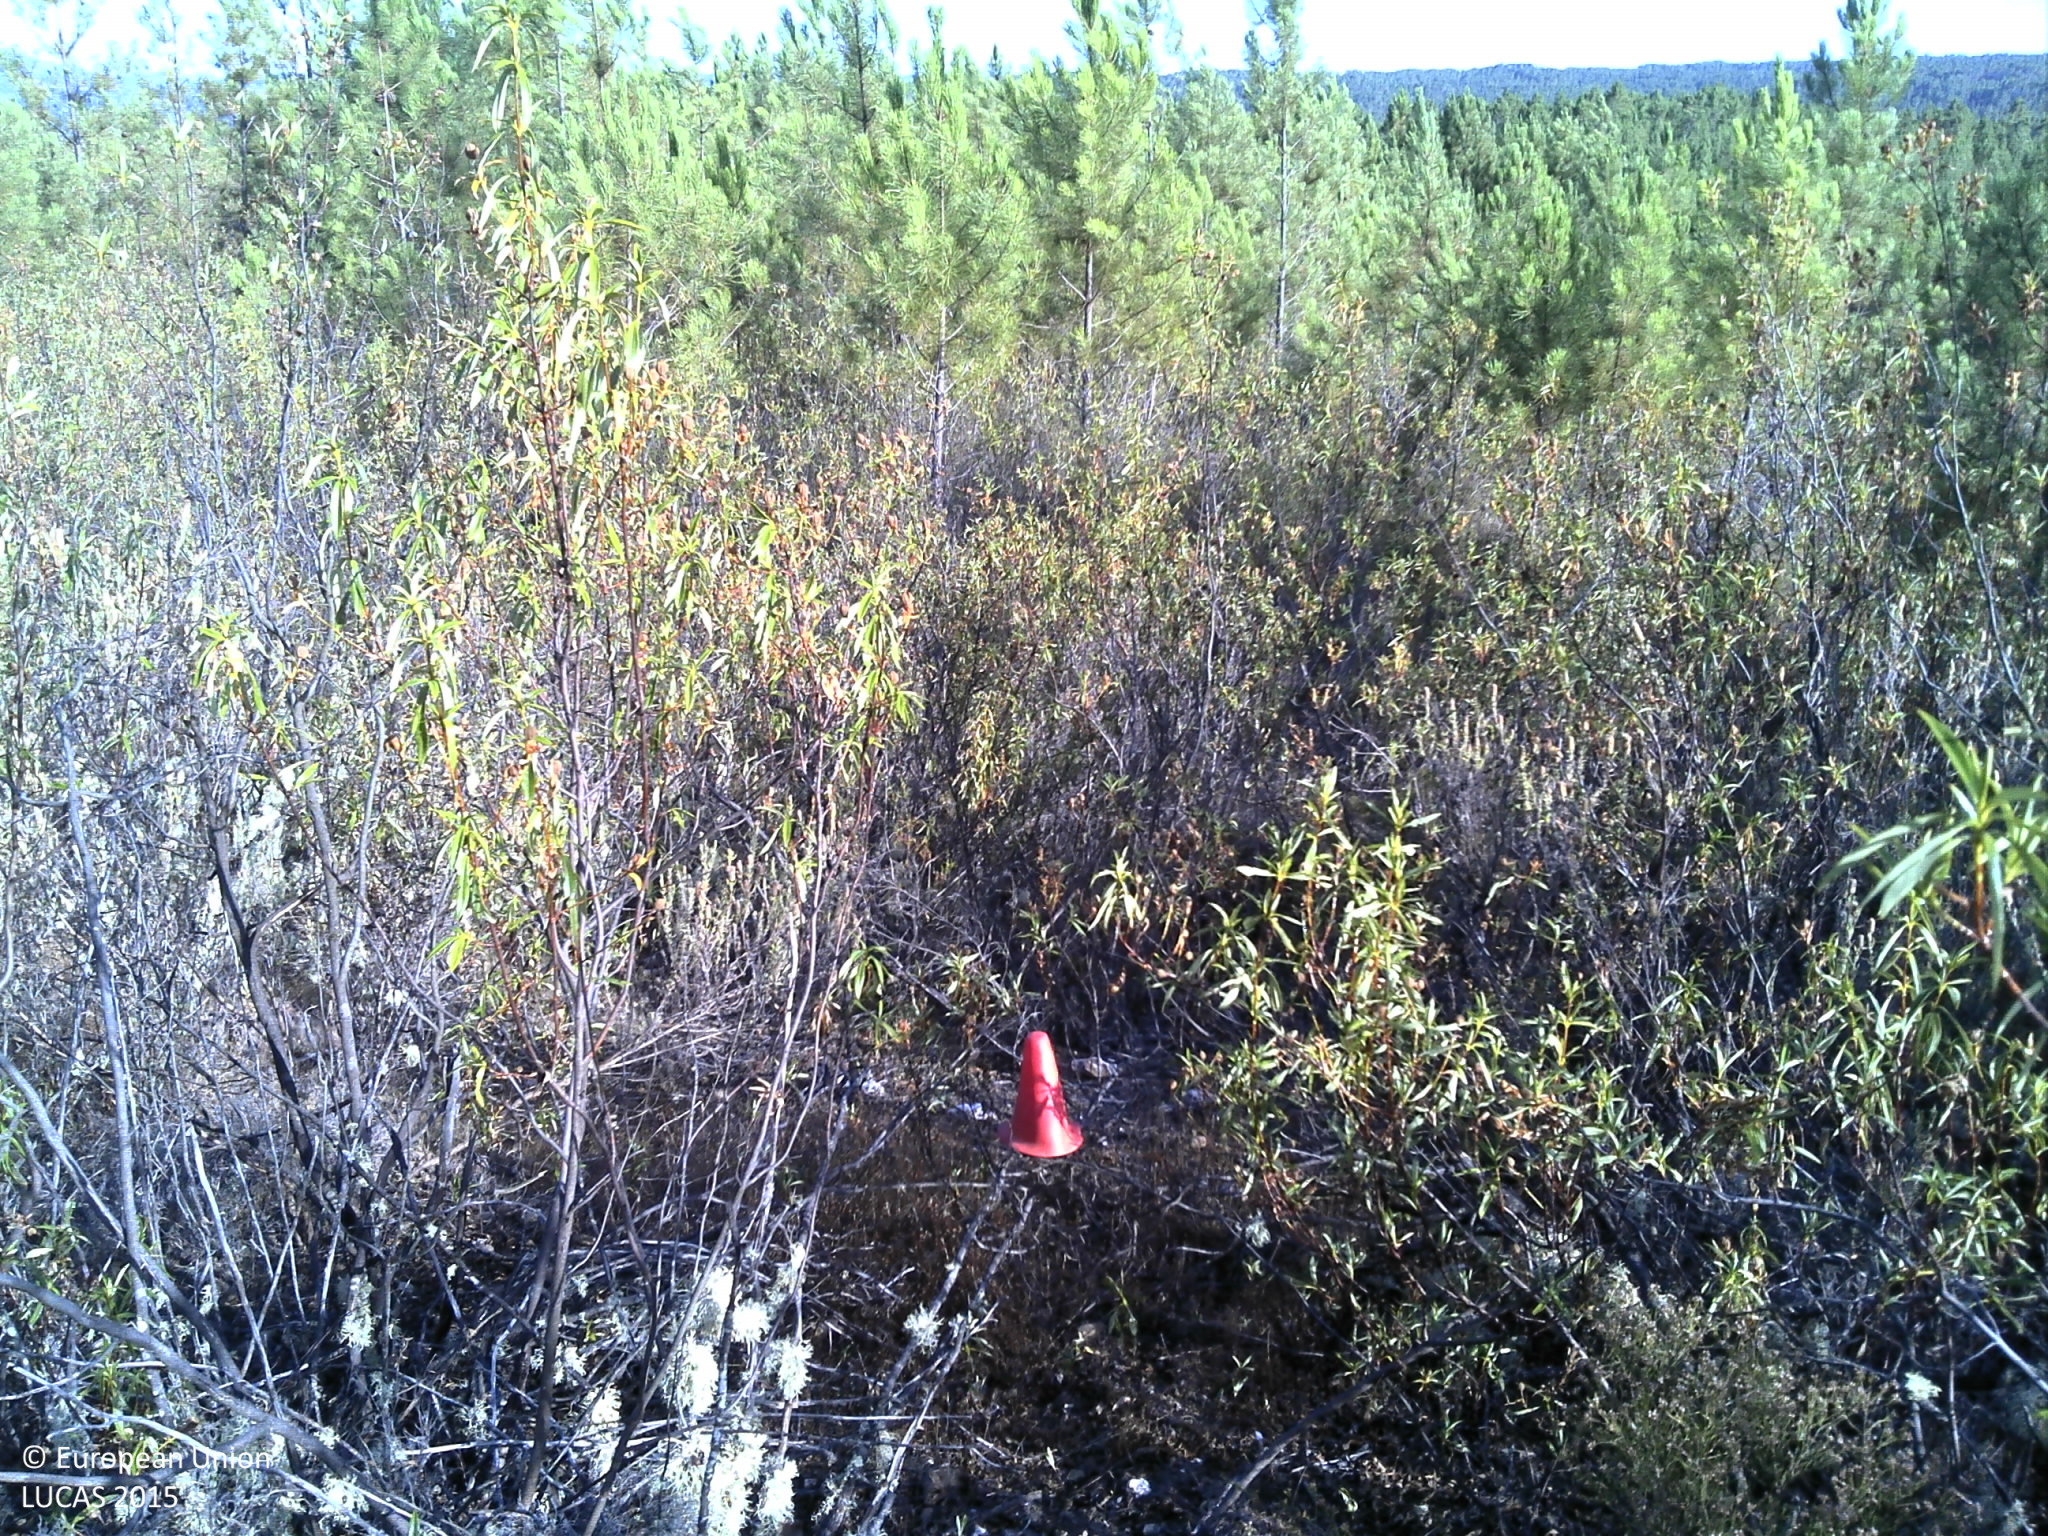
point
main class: Woodland
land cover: Pine dominated coniferous woodland
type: coniferous forest of the mediterranean region
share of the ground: < 10 %
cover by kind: shrubs 90 %, coniferous forest trees 10 %
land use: Forestry
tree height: < 5 m
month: July
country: PT
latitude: 39.7322
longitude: -7.8052
